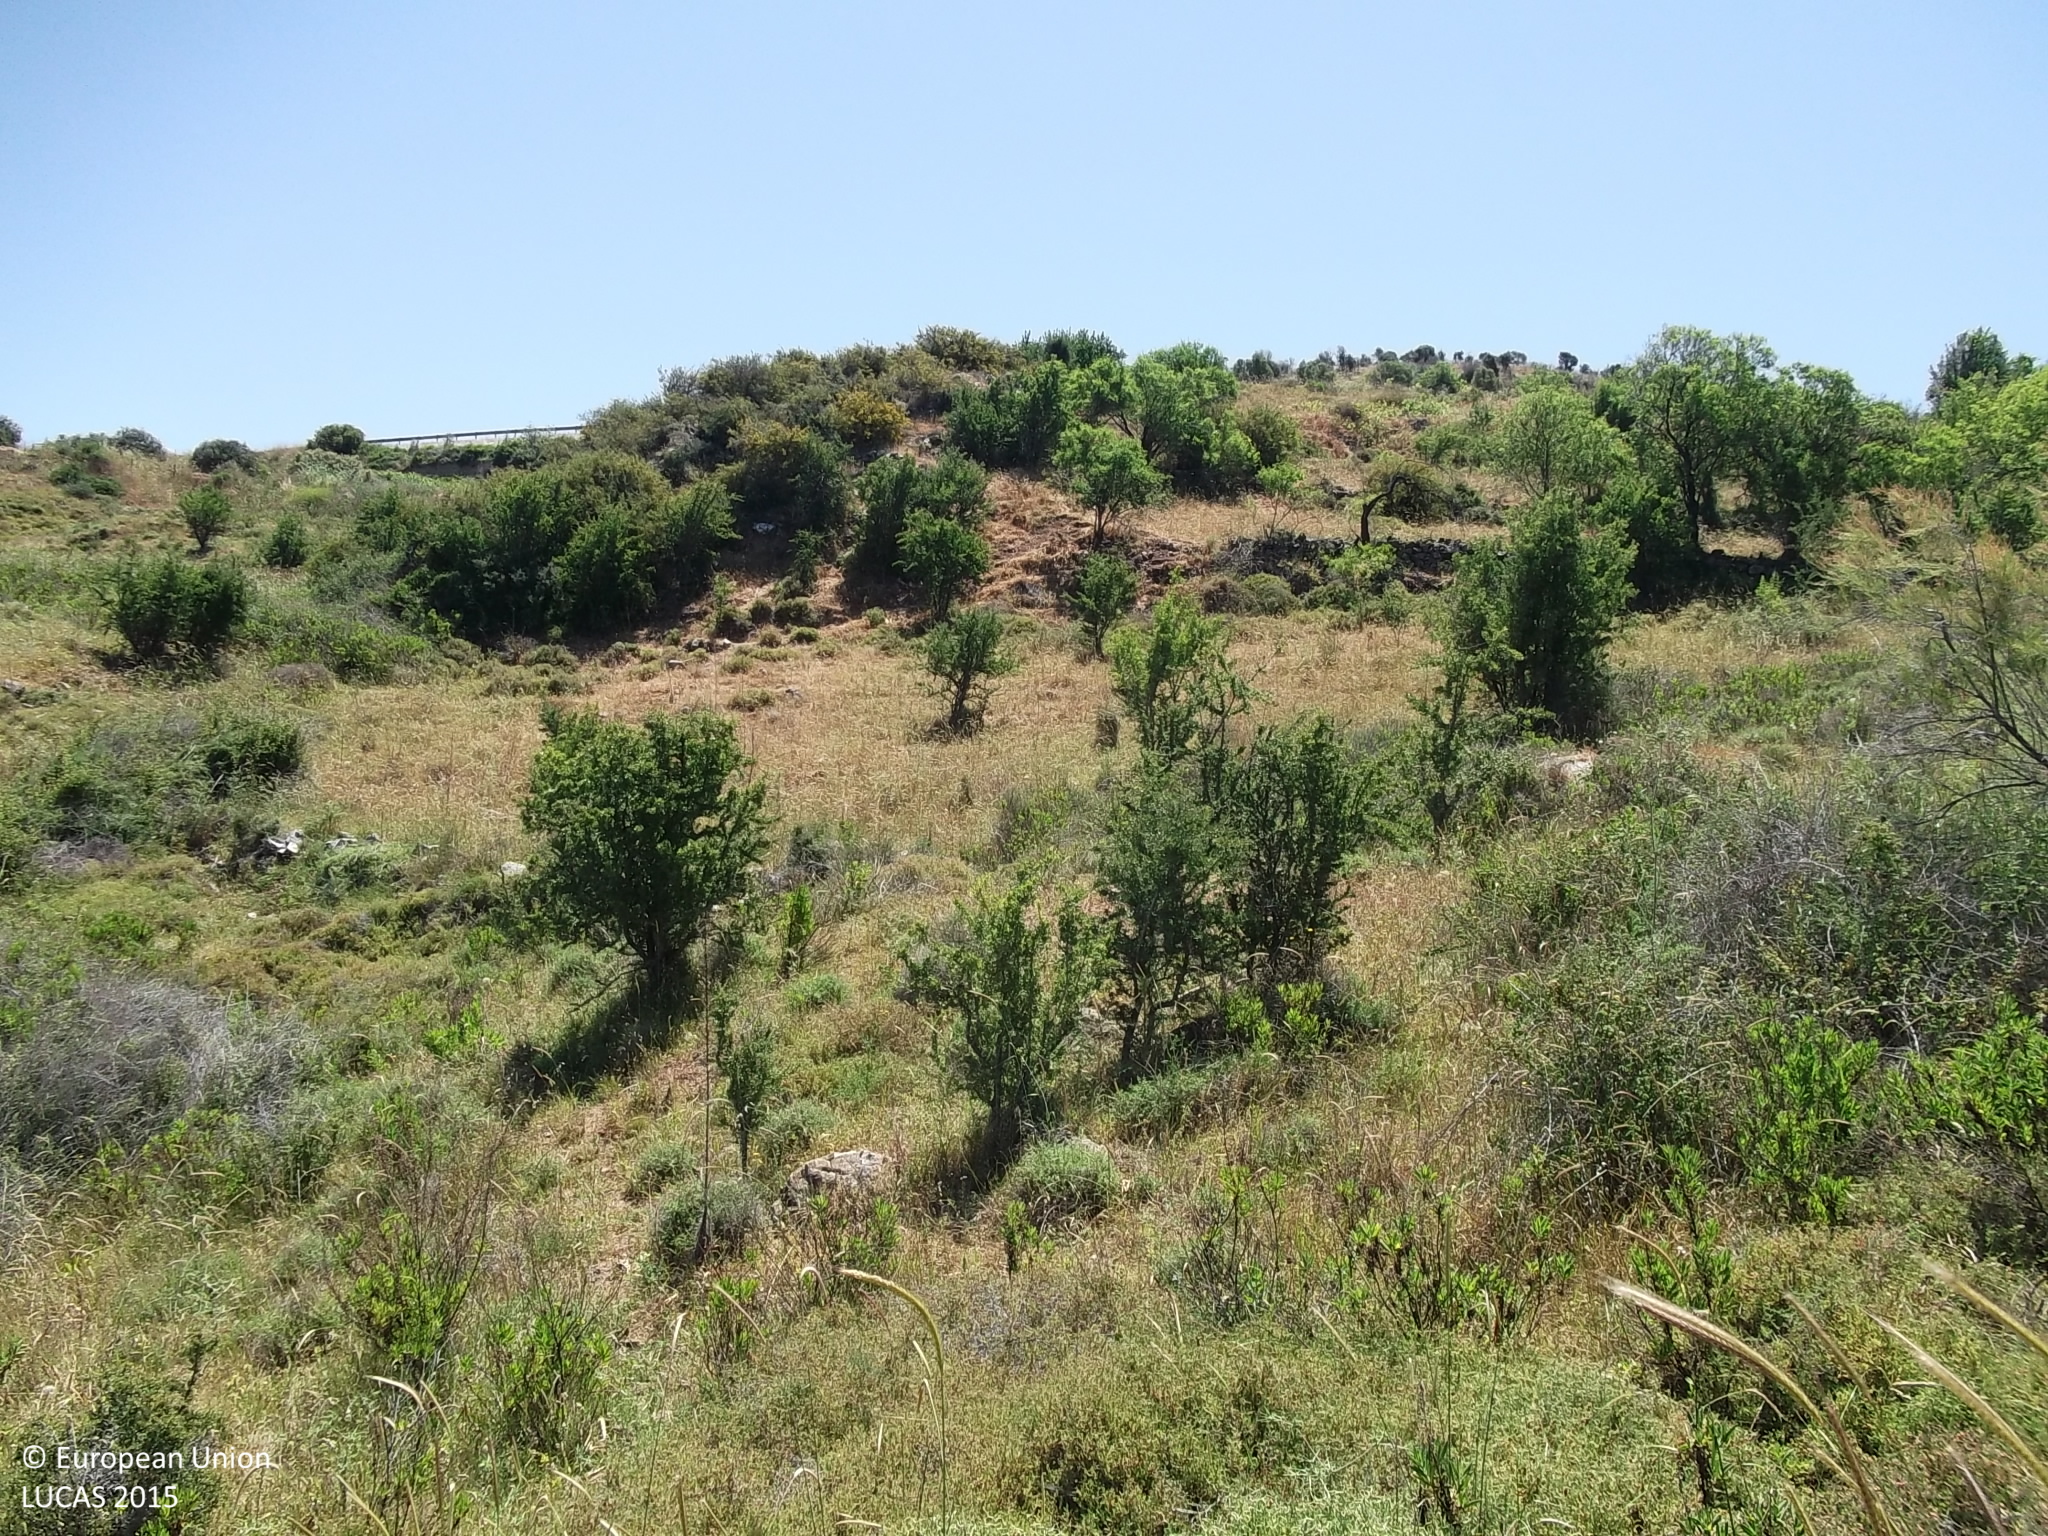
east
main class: Grassland
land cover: Grassland without tree/shrub cover
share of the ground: > 75 %
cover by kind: herbaceous plants 95 %, shrubs 5 %
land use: Semi-natural and natural areas not in use
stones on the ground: 25 - 50 %
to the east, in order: Grassland without tree/shrub cover; Shrubland without tree cover; Rivers and streams; Shrubland without tree cover; Rock outcrops; Grassland with sparse tree/shrub cover; Fences; Olive groves; Fences; Mixed cereals for fodder; Paved roads, cycling and walking lanes; Grassland without tree/shrub cover
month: May
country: CY
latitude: 34.7793
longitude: 32.5395
